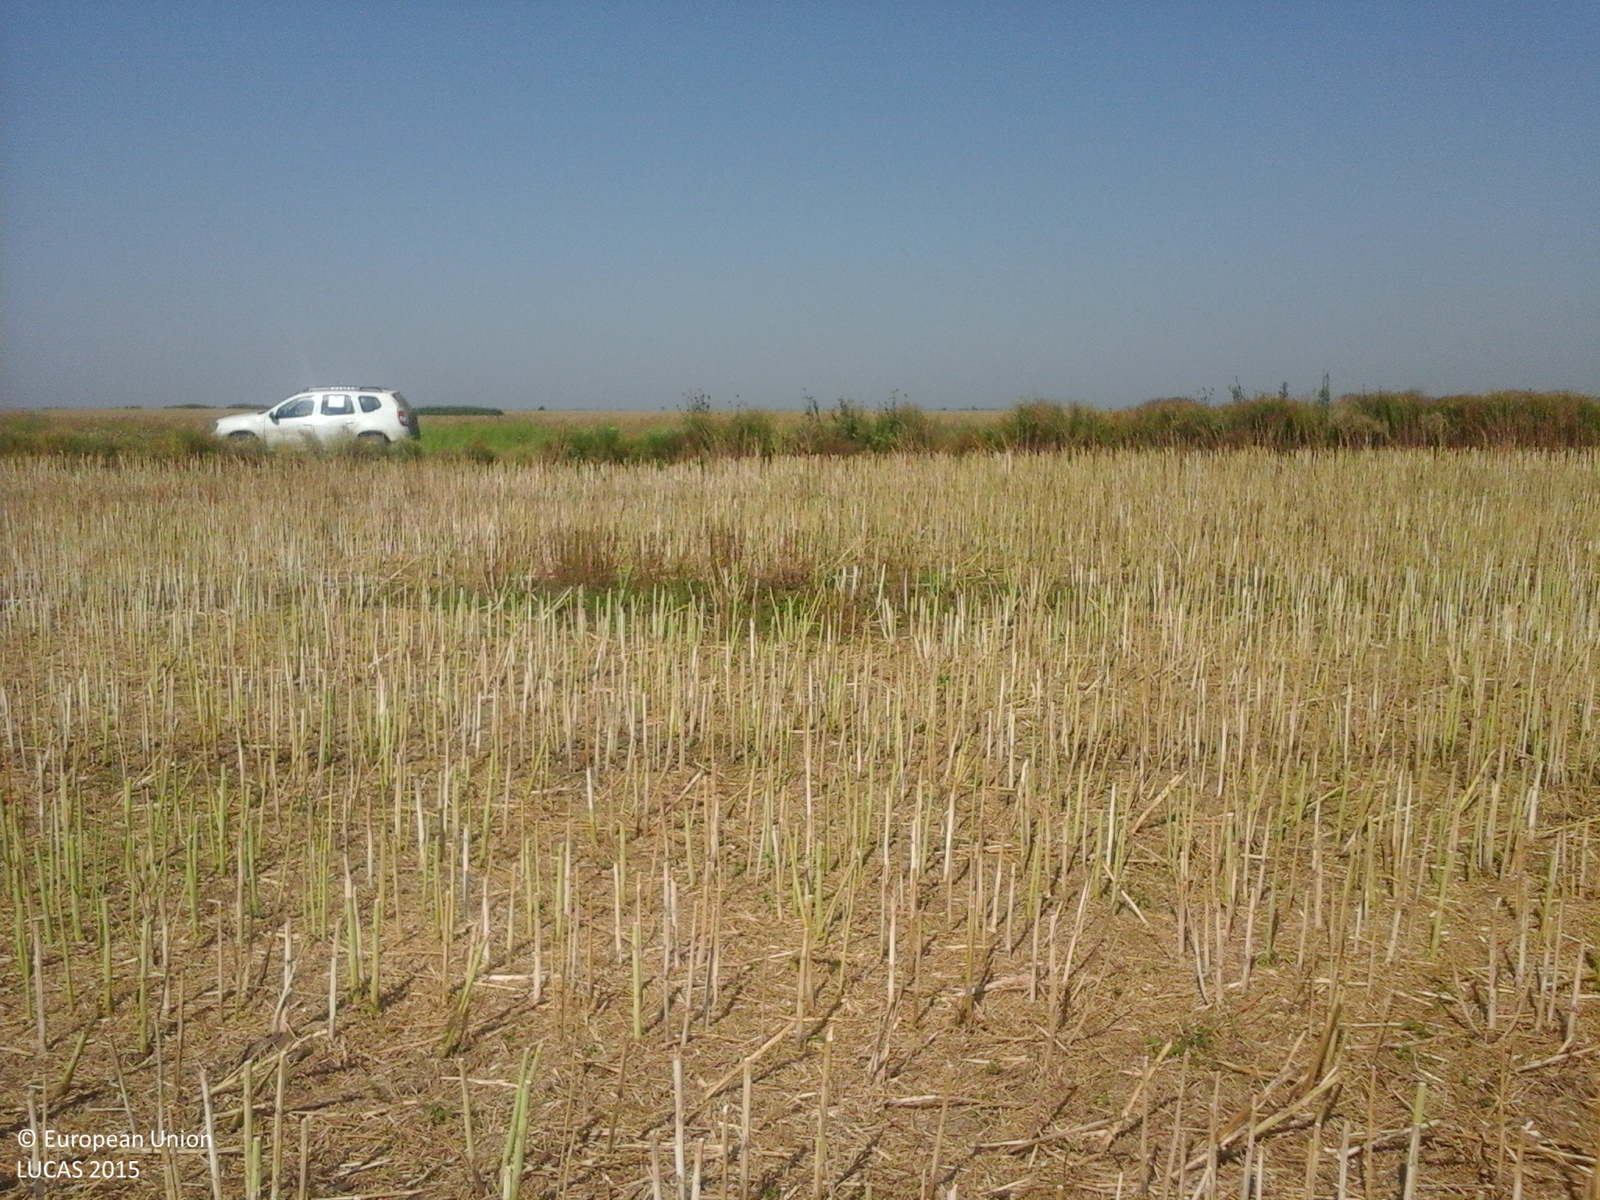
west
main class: Cropland
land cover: Rape and turnip rape
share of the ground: < 10 %
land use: Agriculture (excluding fallow land and kitchen gardens)
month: July
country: RO
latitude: 44.0778
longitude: 24.7444
